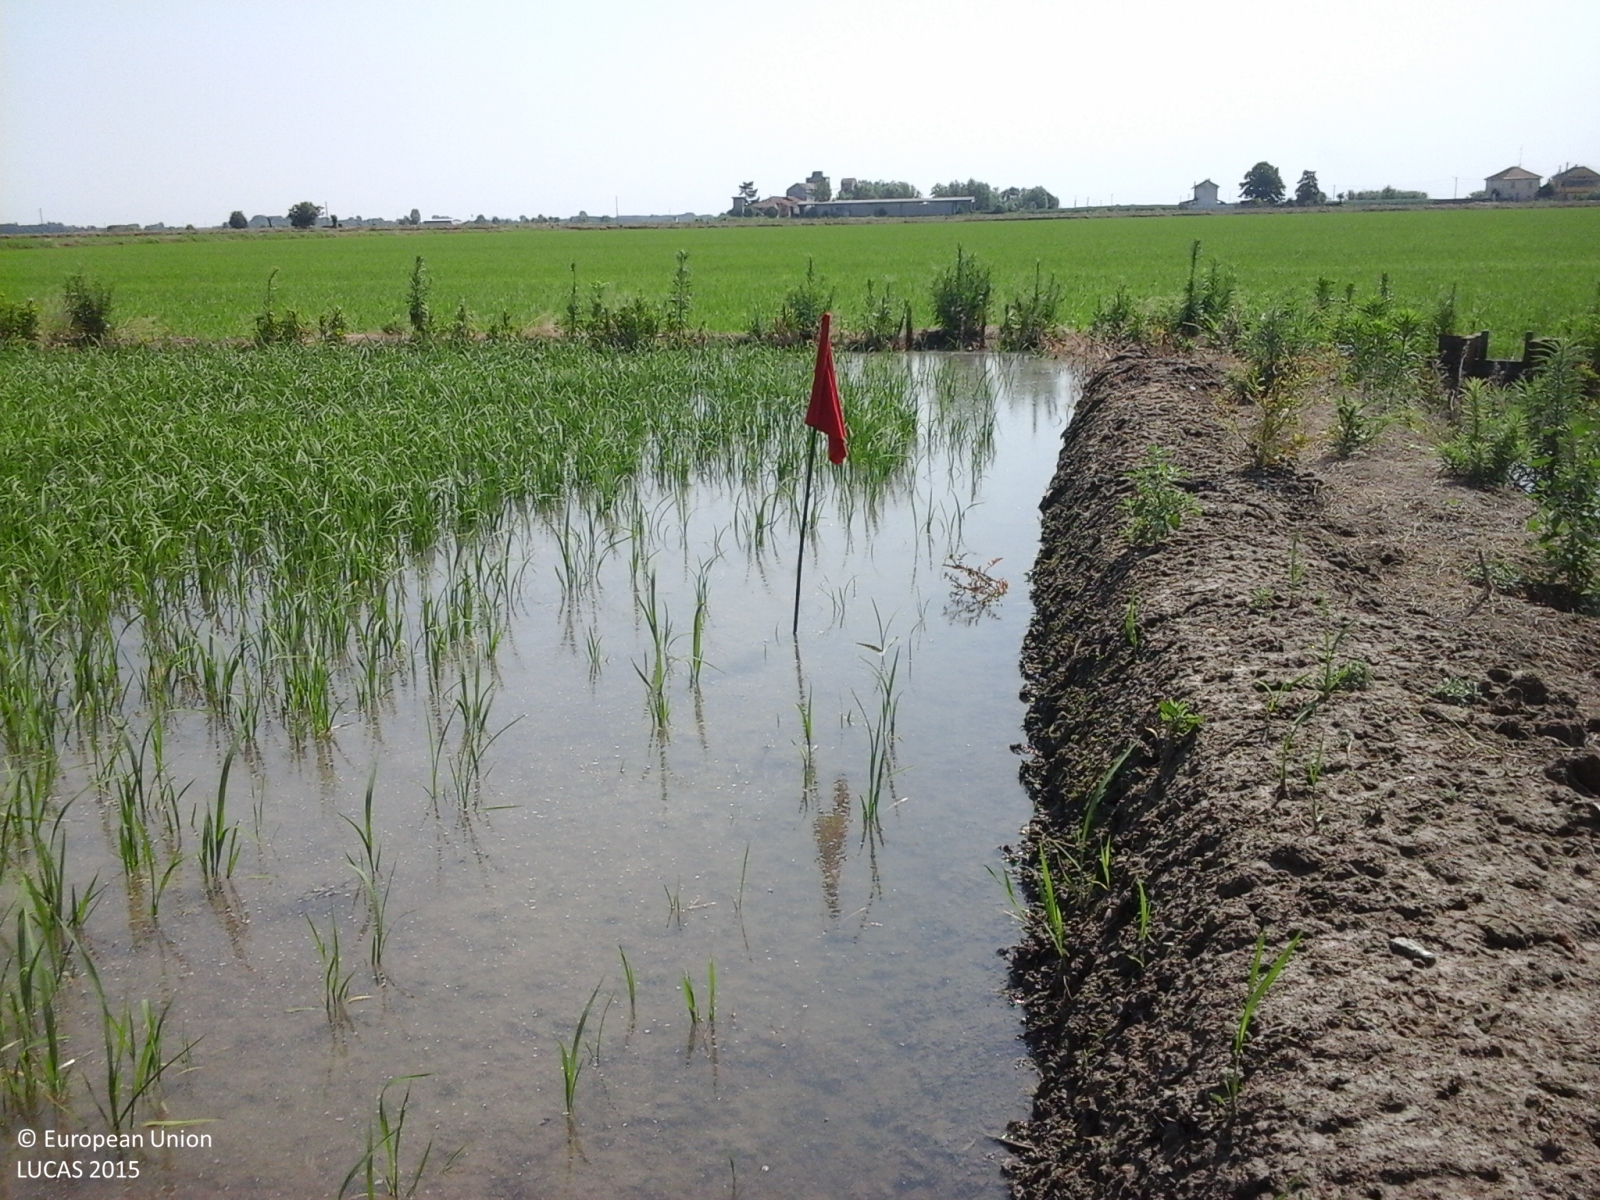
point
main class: Cropland
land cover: Rice
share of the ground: 25 - 50 %
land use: Agriculture (excluding fallow land and kitchen gardens)
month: July
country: IT
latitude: 45.2401
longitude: 8.4104
